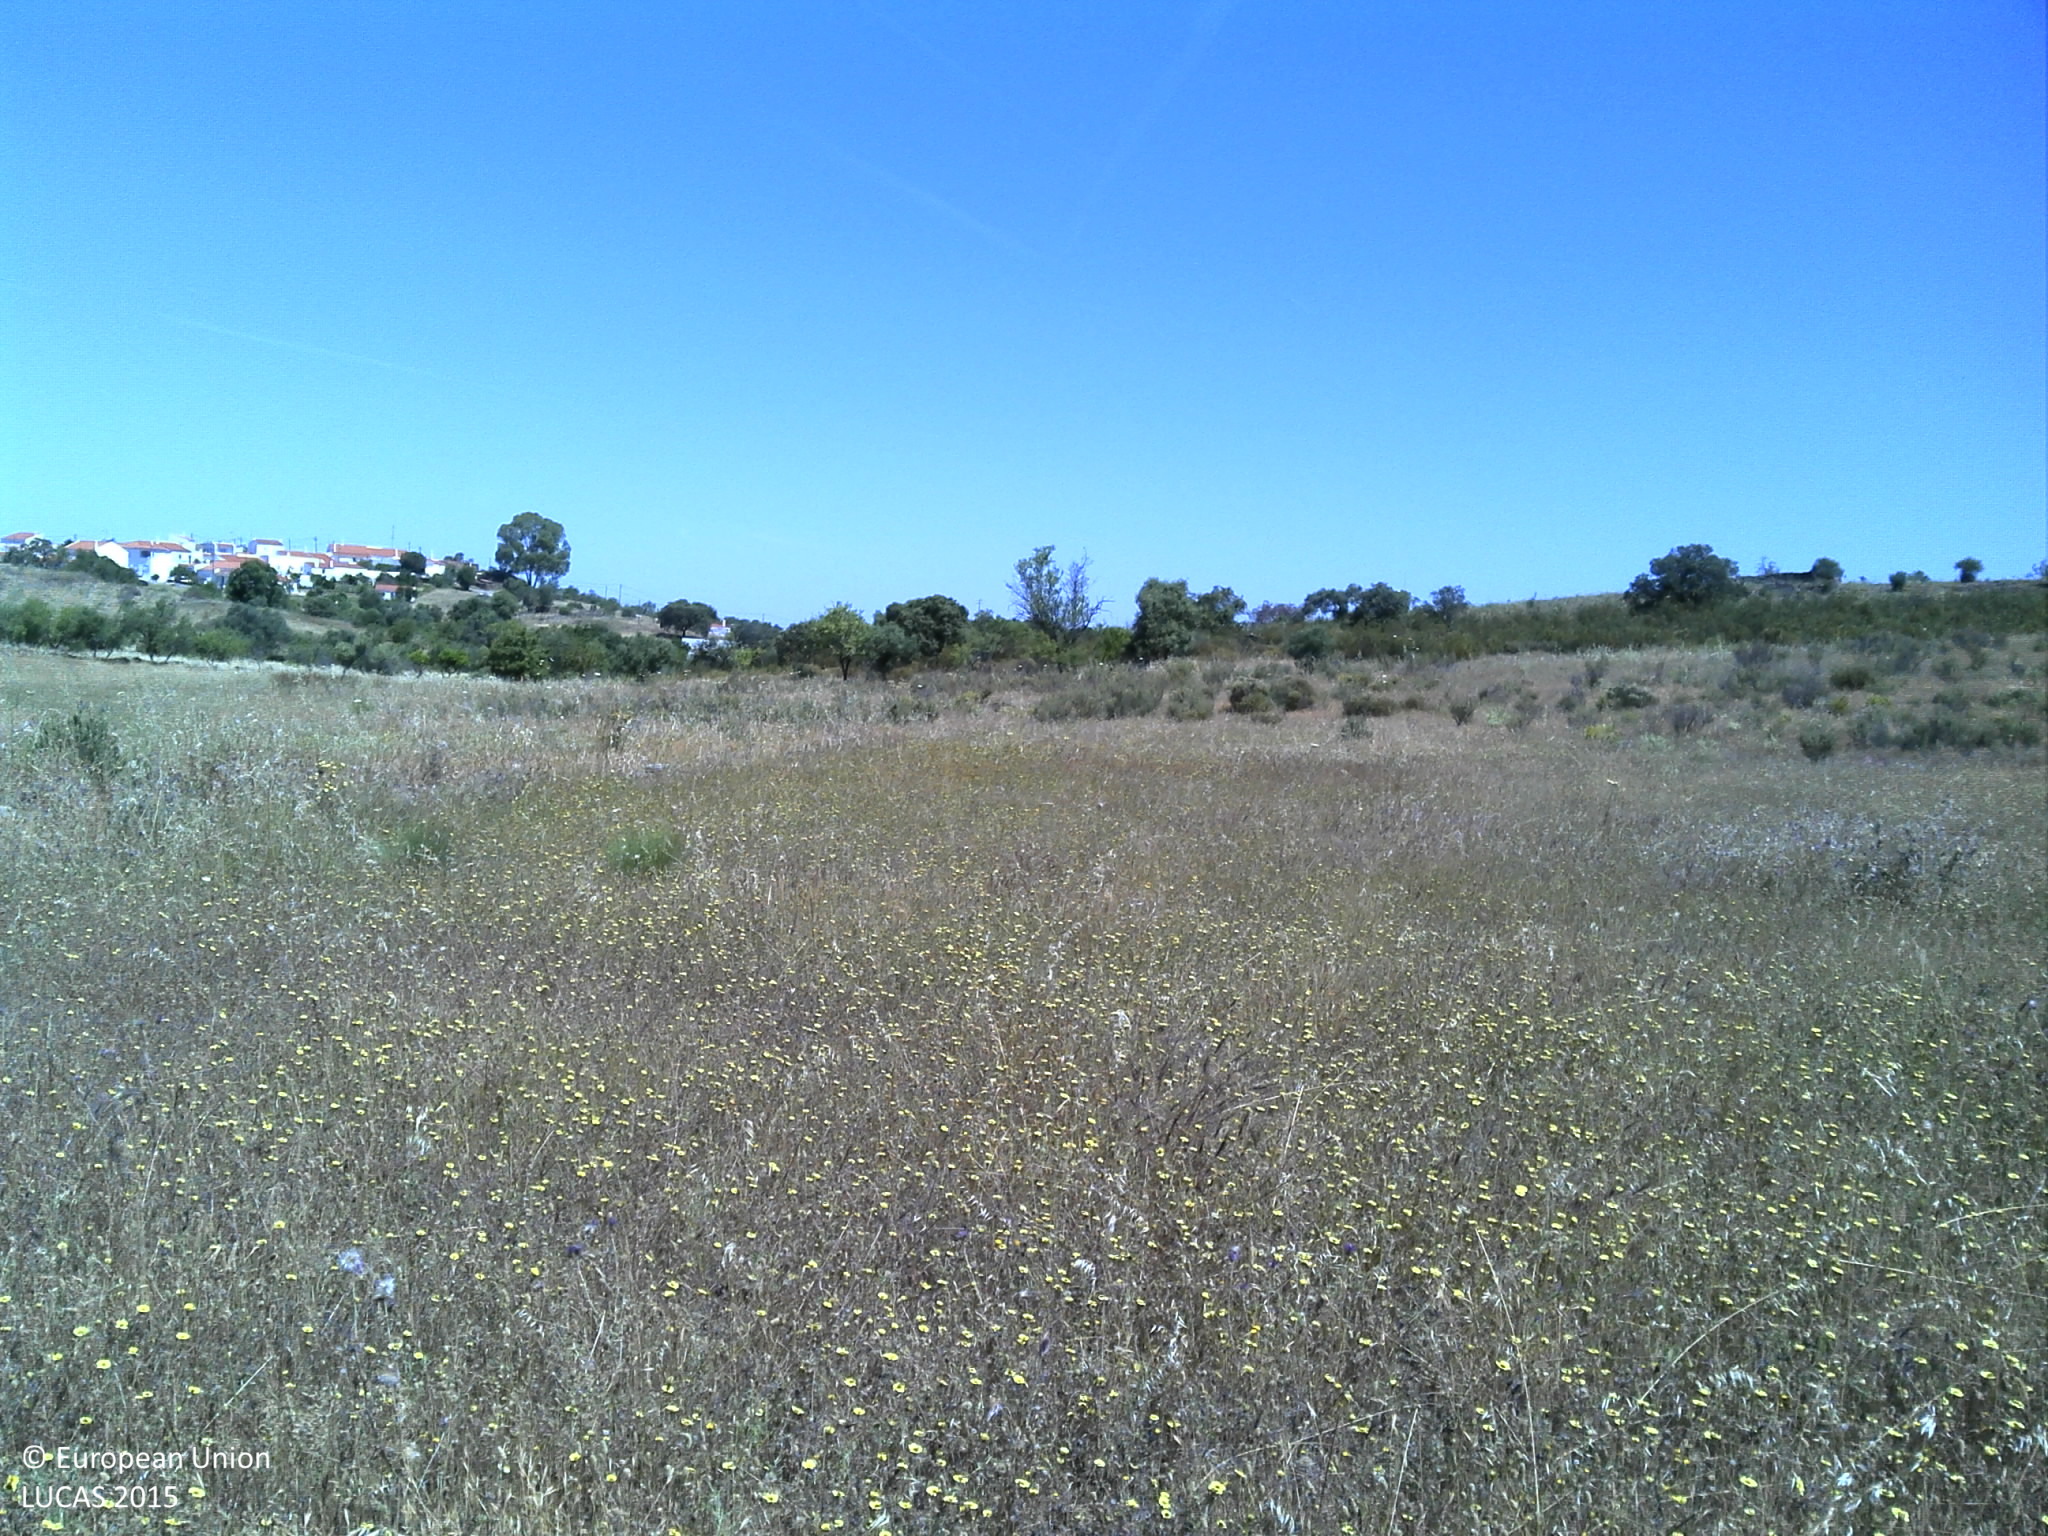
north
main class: Grassland
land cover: Grassland without tree/shrub cover
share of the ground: > 75 %
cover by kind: herbaceous plants 100 %
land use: Agriculture (excluding fallow land and kitchen gardens)
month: May
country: PT
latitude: 37.4221
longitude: -7.5113
